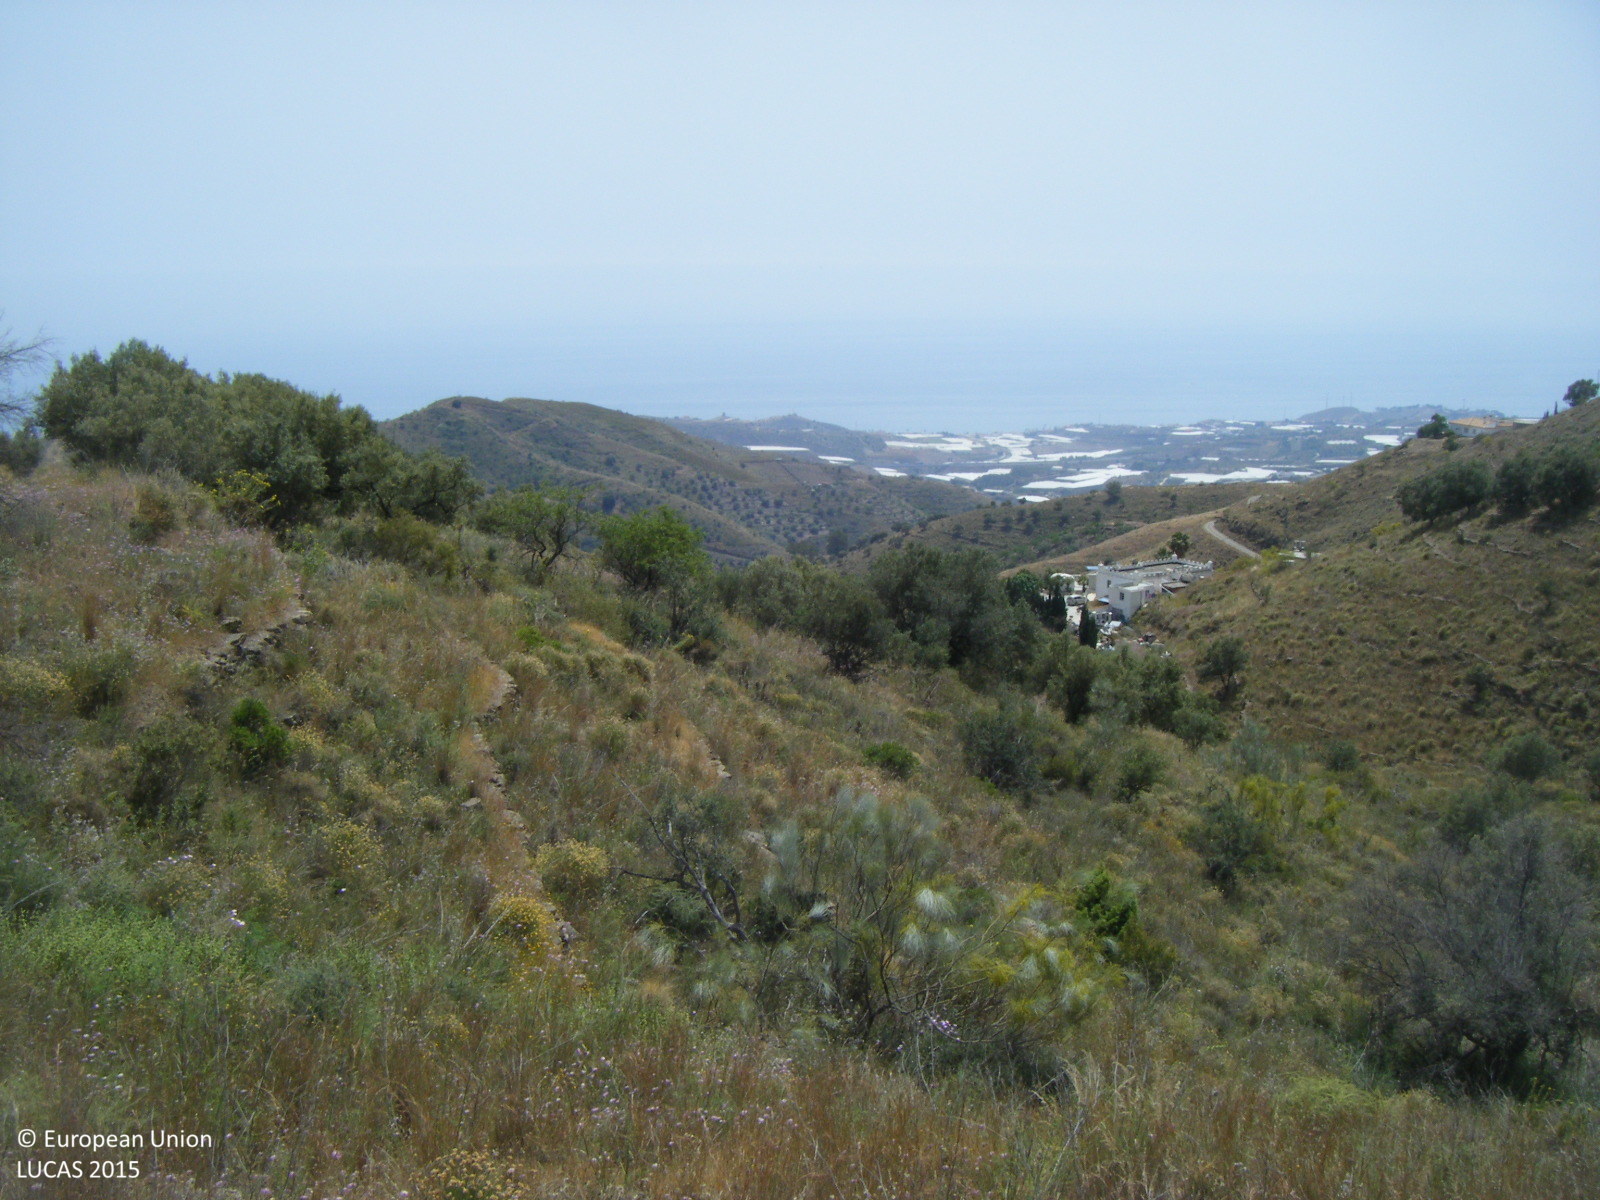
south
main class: Grassland
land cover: Grassland without tree/shrub cover
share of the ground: > 75 %
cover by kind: herbaceous plants 95 %, shrubs 5 %
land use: Semi-natural and natural areas not in use
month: May
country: ES
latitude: 36.7793
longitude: -4.0036
